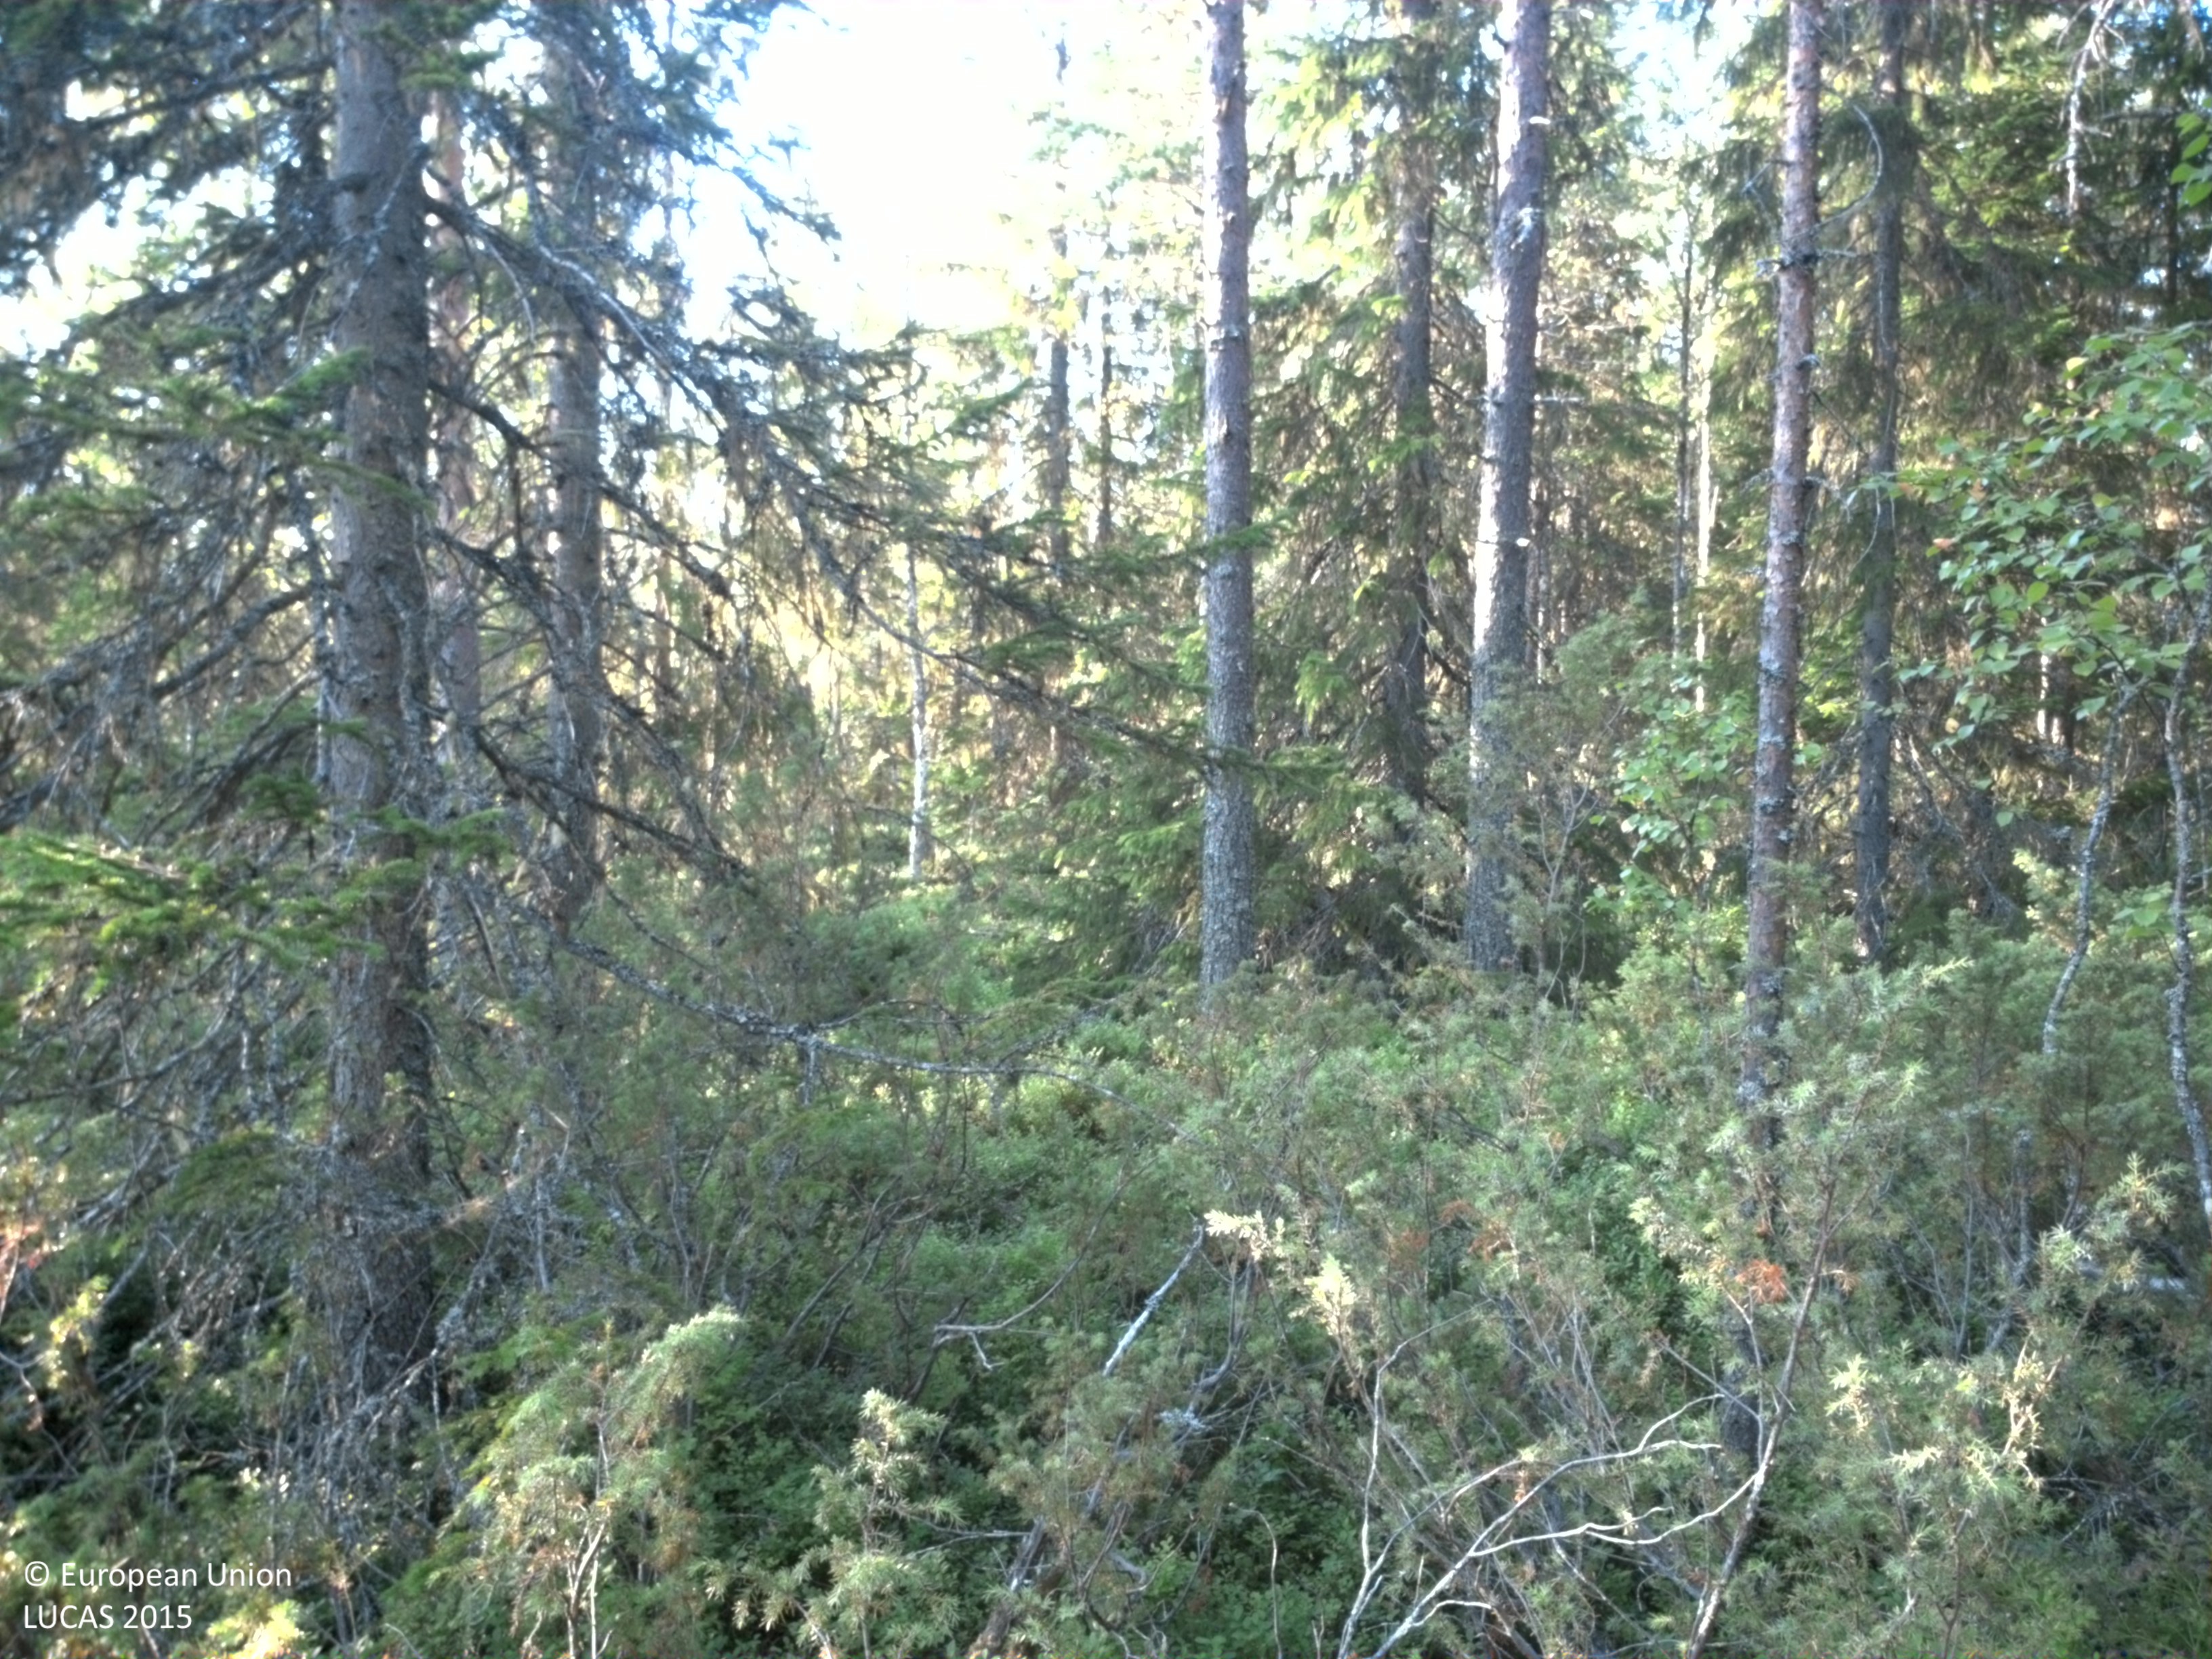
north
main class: Woodland
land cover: Spruce dominated coniferous woodland
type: boreal forest
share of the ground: 50 - 75 %
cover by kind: coniferous forest trees 65 %, shrubs 25 %, lichens and mosses 10 %
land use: Forestry
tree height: > 5 m
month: August
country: SE
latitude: 61.8551
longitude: 15.1708
